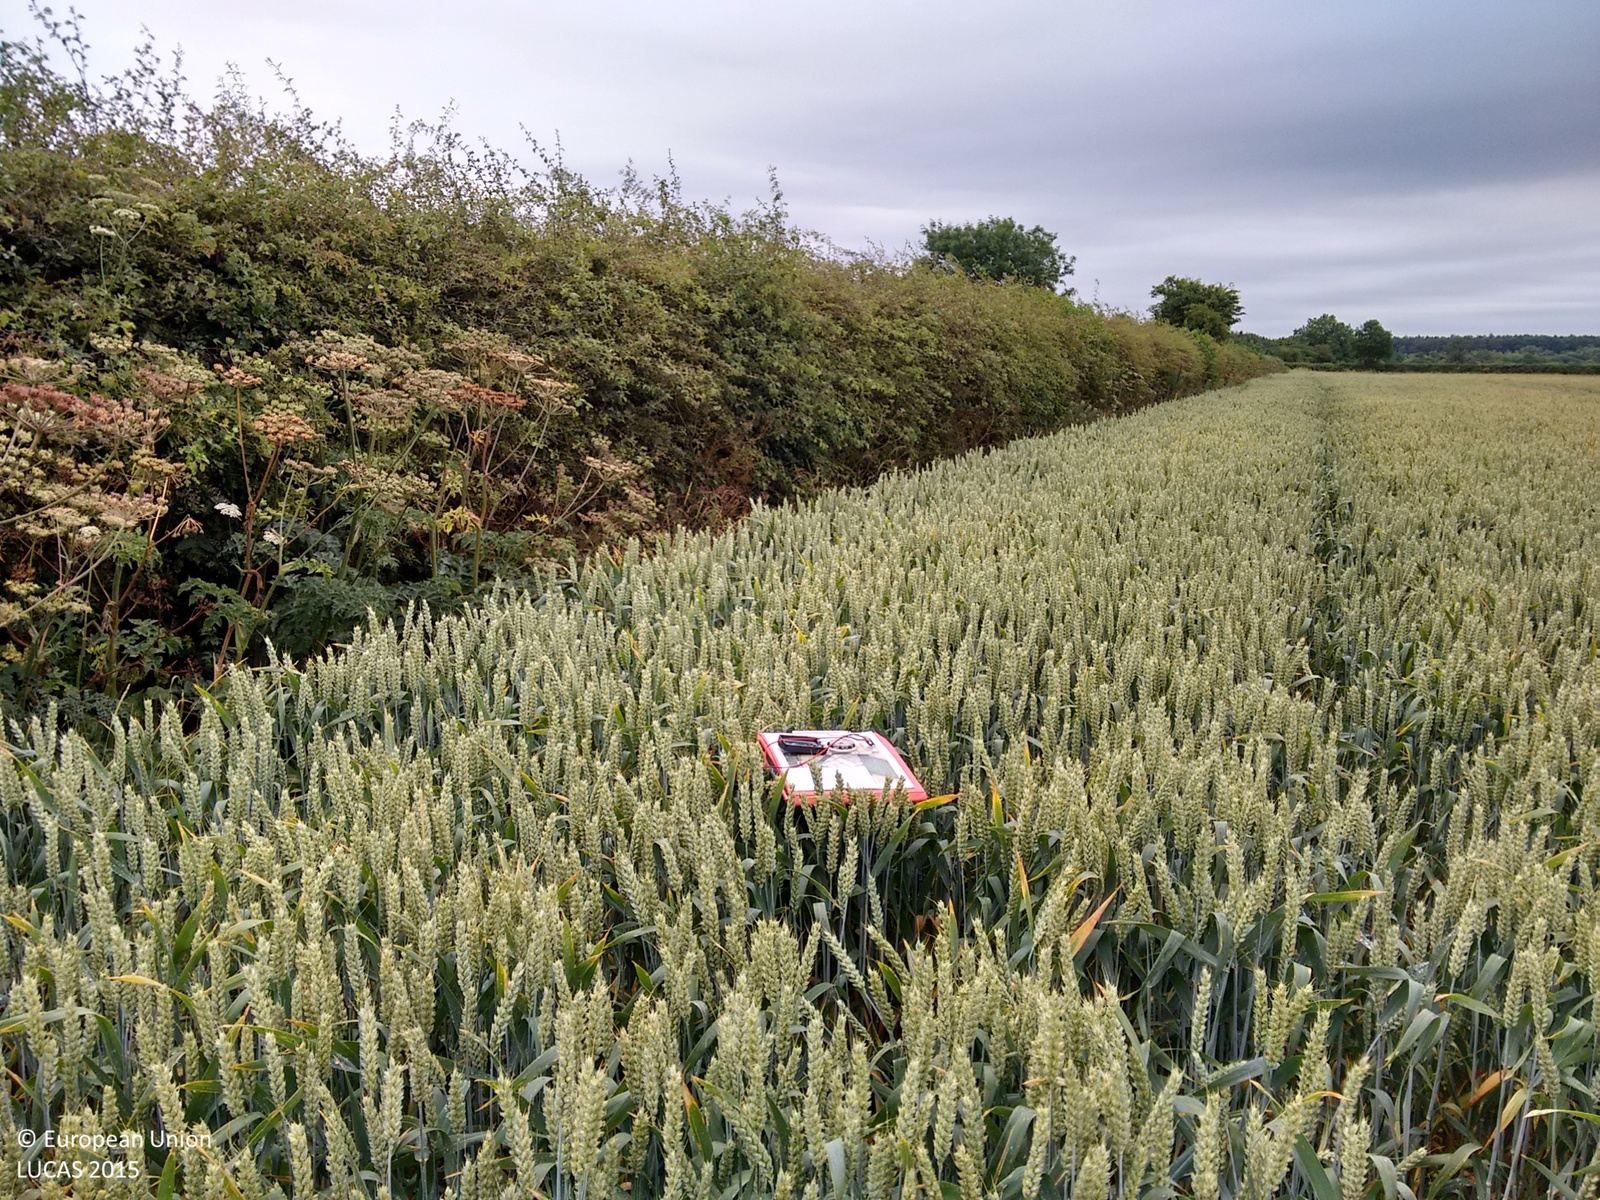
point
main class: Cropland
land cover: Common wheat
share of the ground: > 75 %
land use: Agriculture (excluding fallow land and kitchen gardens)
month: July
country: GB
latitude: 52.5302
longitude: -0.6682
